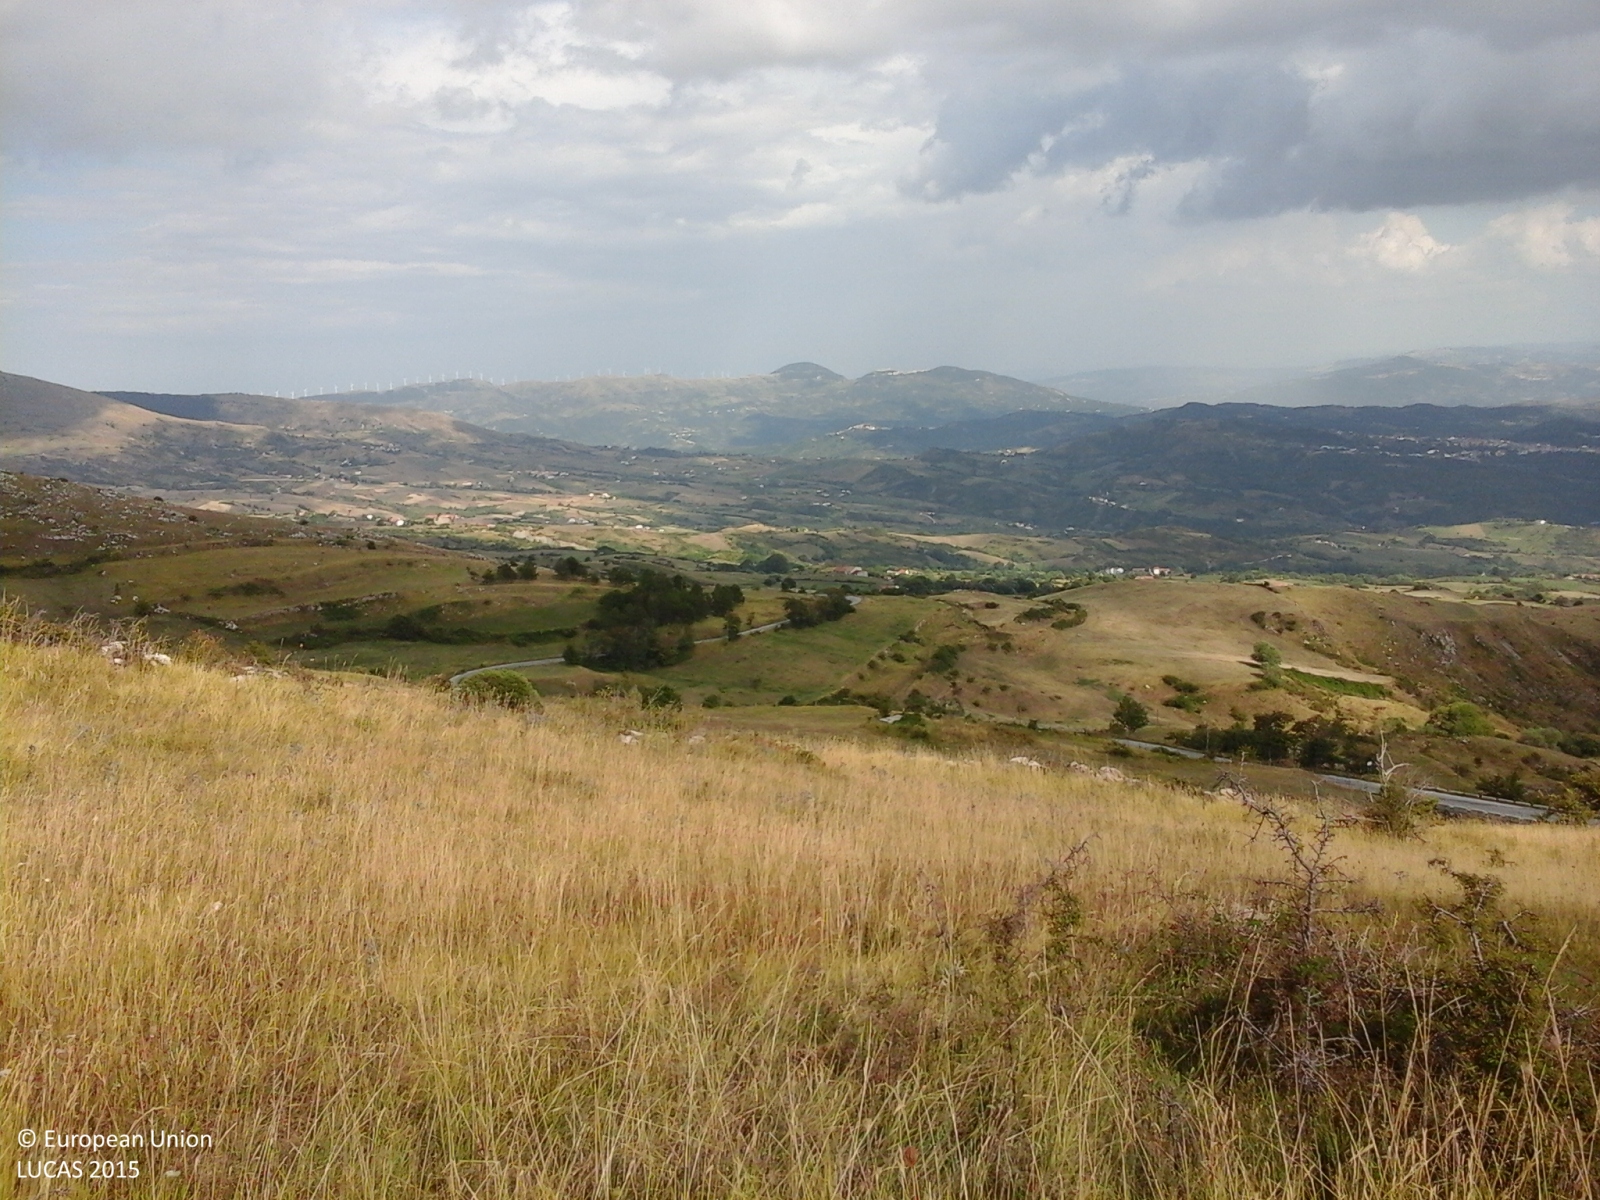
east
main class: Grassland
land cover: Grassland without tree/shrub cover
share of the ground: > 75 %
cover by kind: herbaceous plants 100 %
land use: Agriculture (excluding fallow land and kitchen gardens)
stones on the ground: 25 - 50 %
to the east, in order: Grassland without tree/shrub cover; Ditches and canals; Temporary grasslands
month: August
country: IT
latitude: 41.8388
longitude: 14.3087
